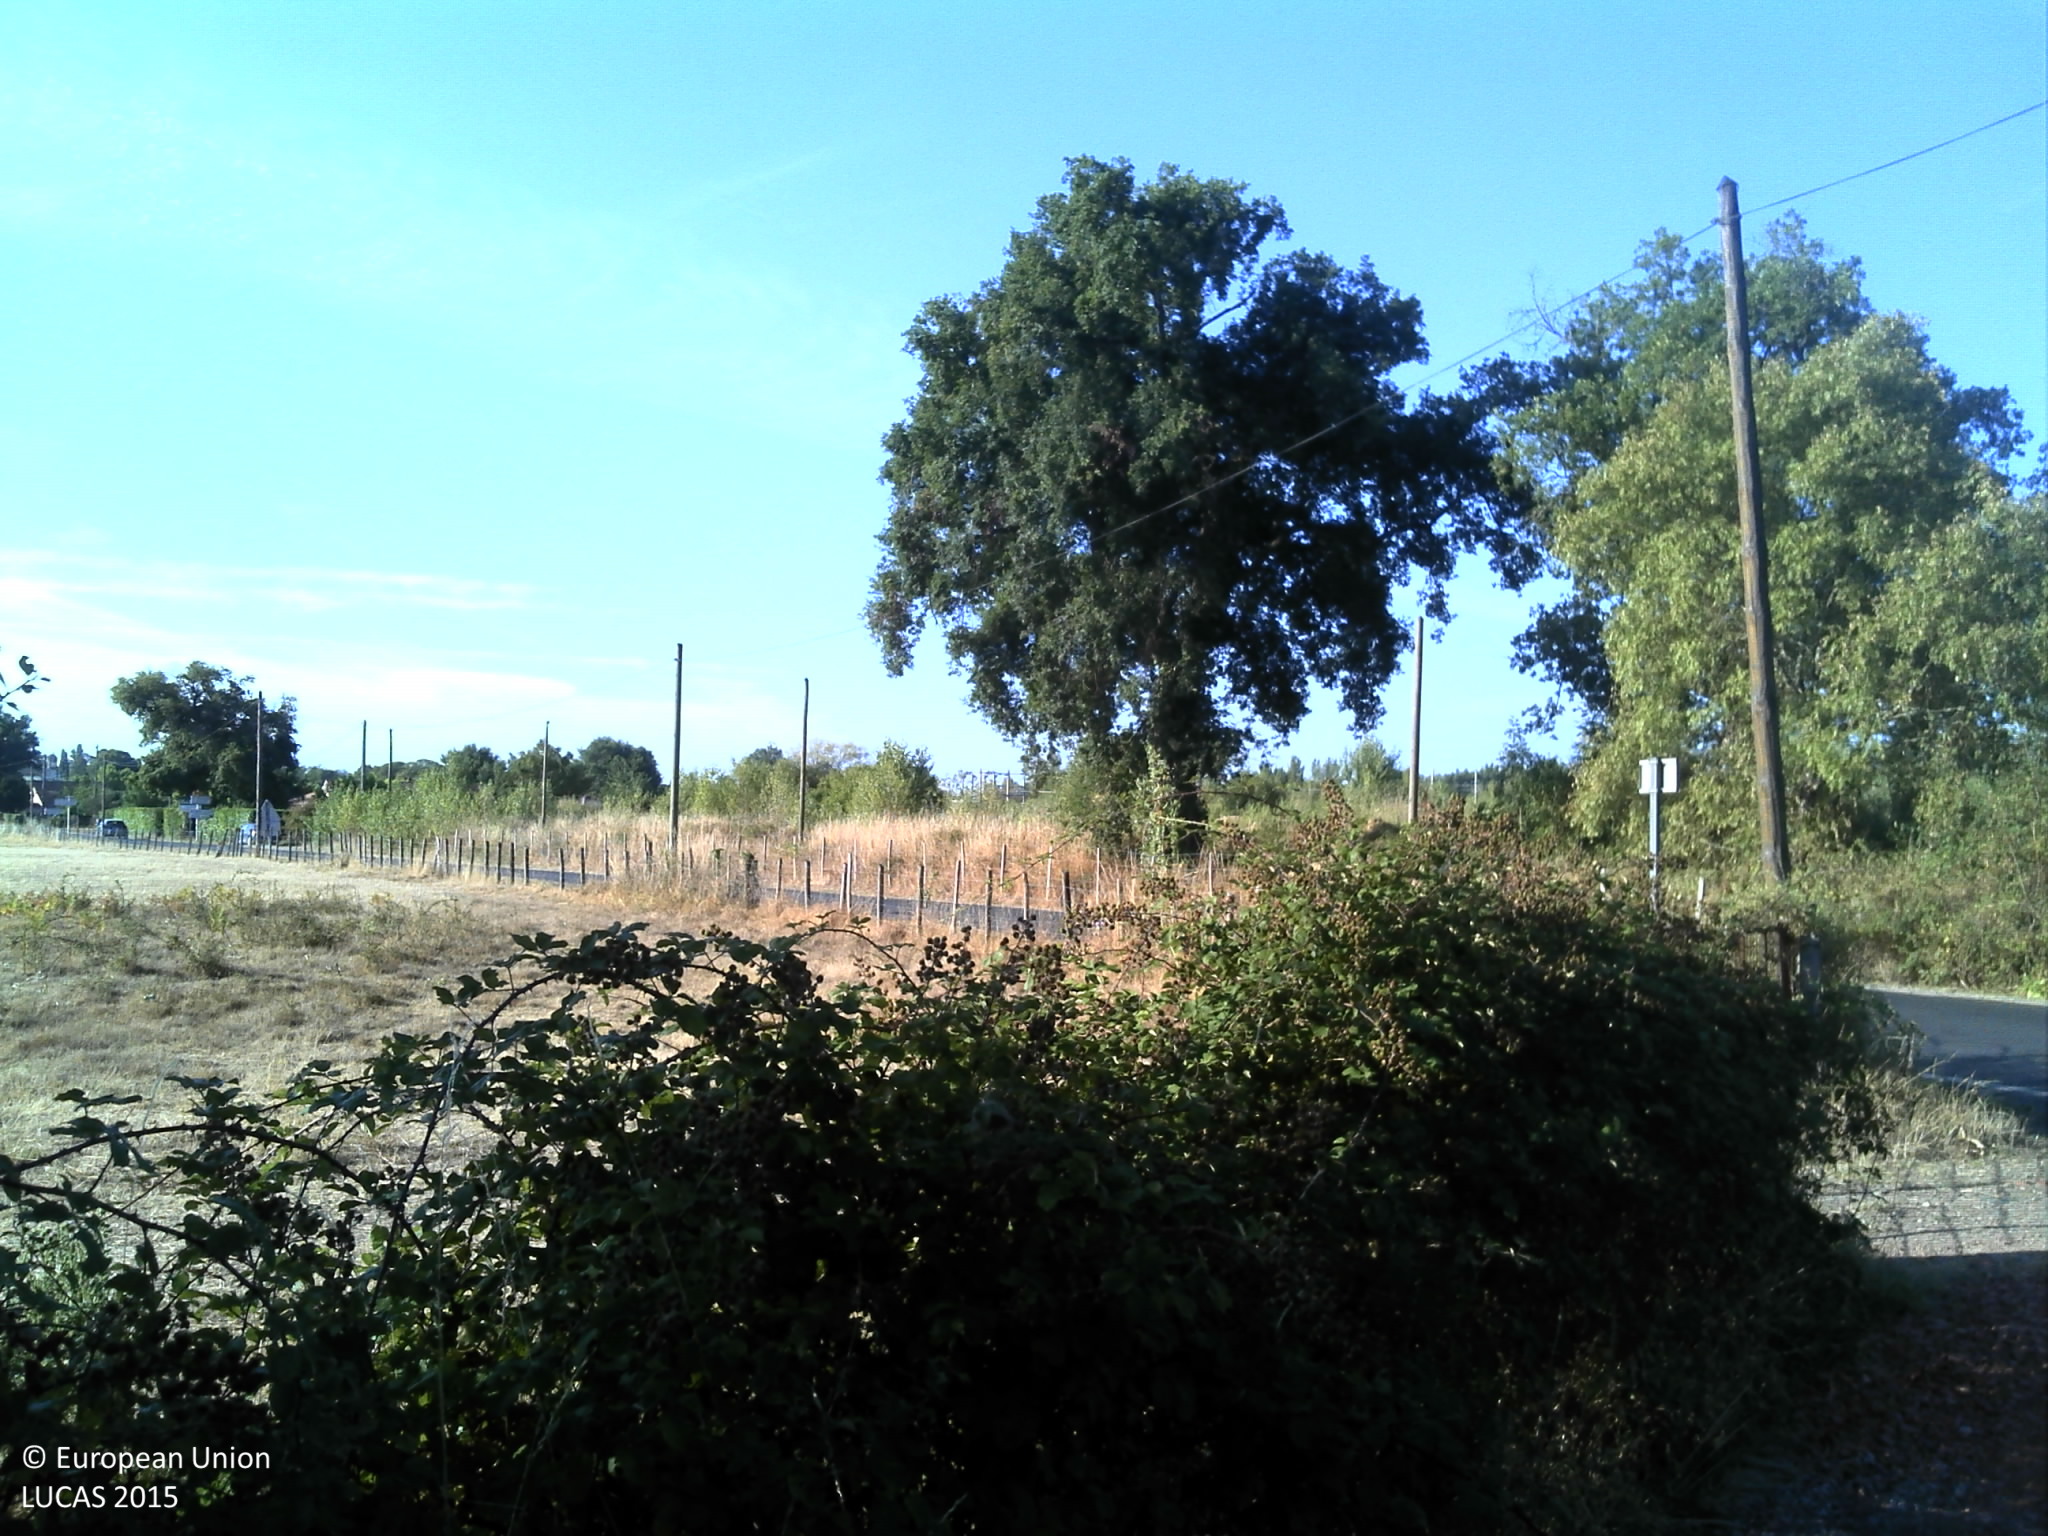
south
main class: Woodland
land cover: Broadleaved woodland
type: floodplain forest
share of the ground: > 75 %
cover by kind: broadleaved forest trees 80 %, shrubs 10 %, herbaceous plants 10 %
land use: Agriculture (excluding fallow land and kitchen gardens)
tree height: > 5 m
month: July
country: FR
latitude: 44.7241
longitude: -0.5090
